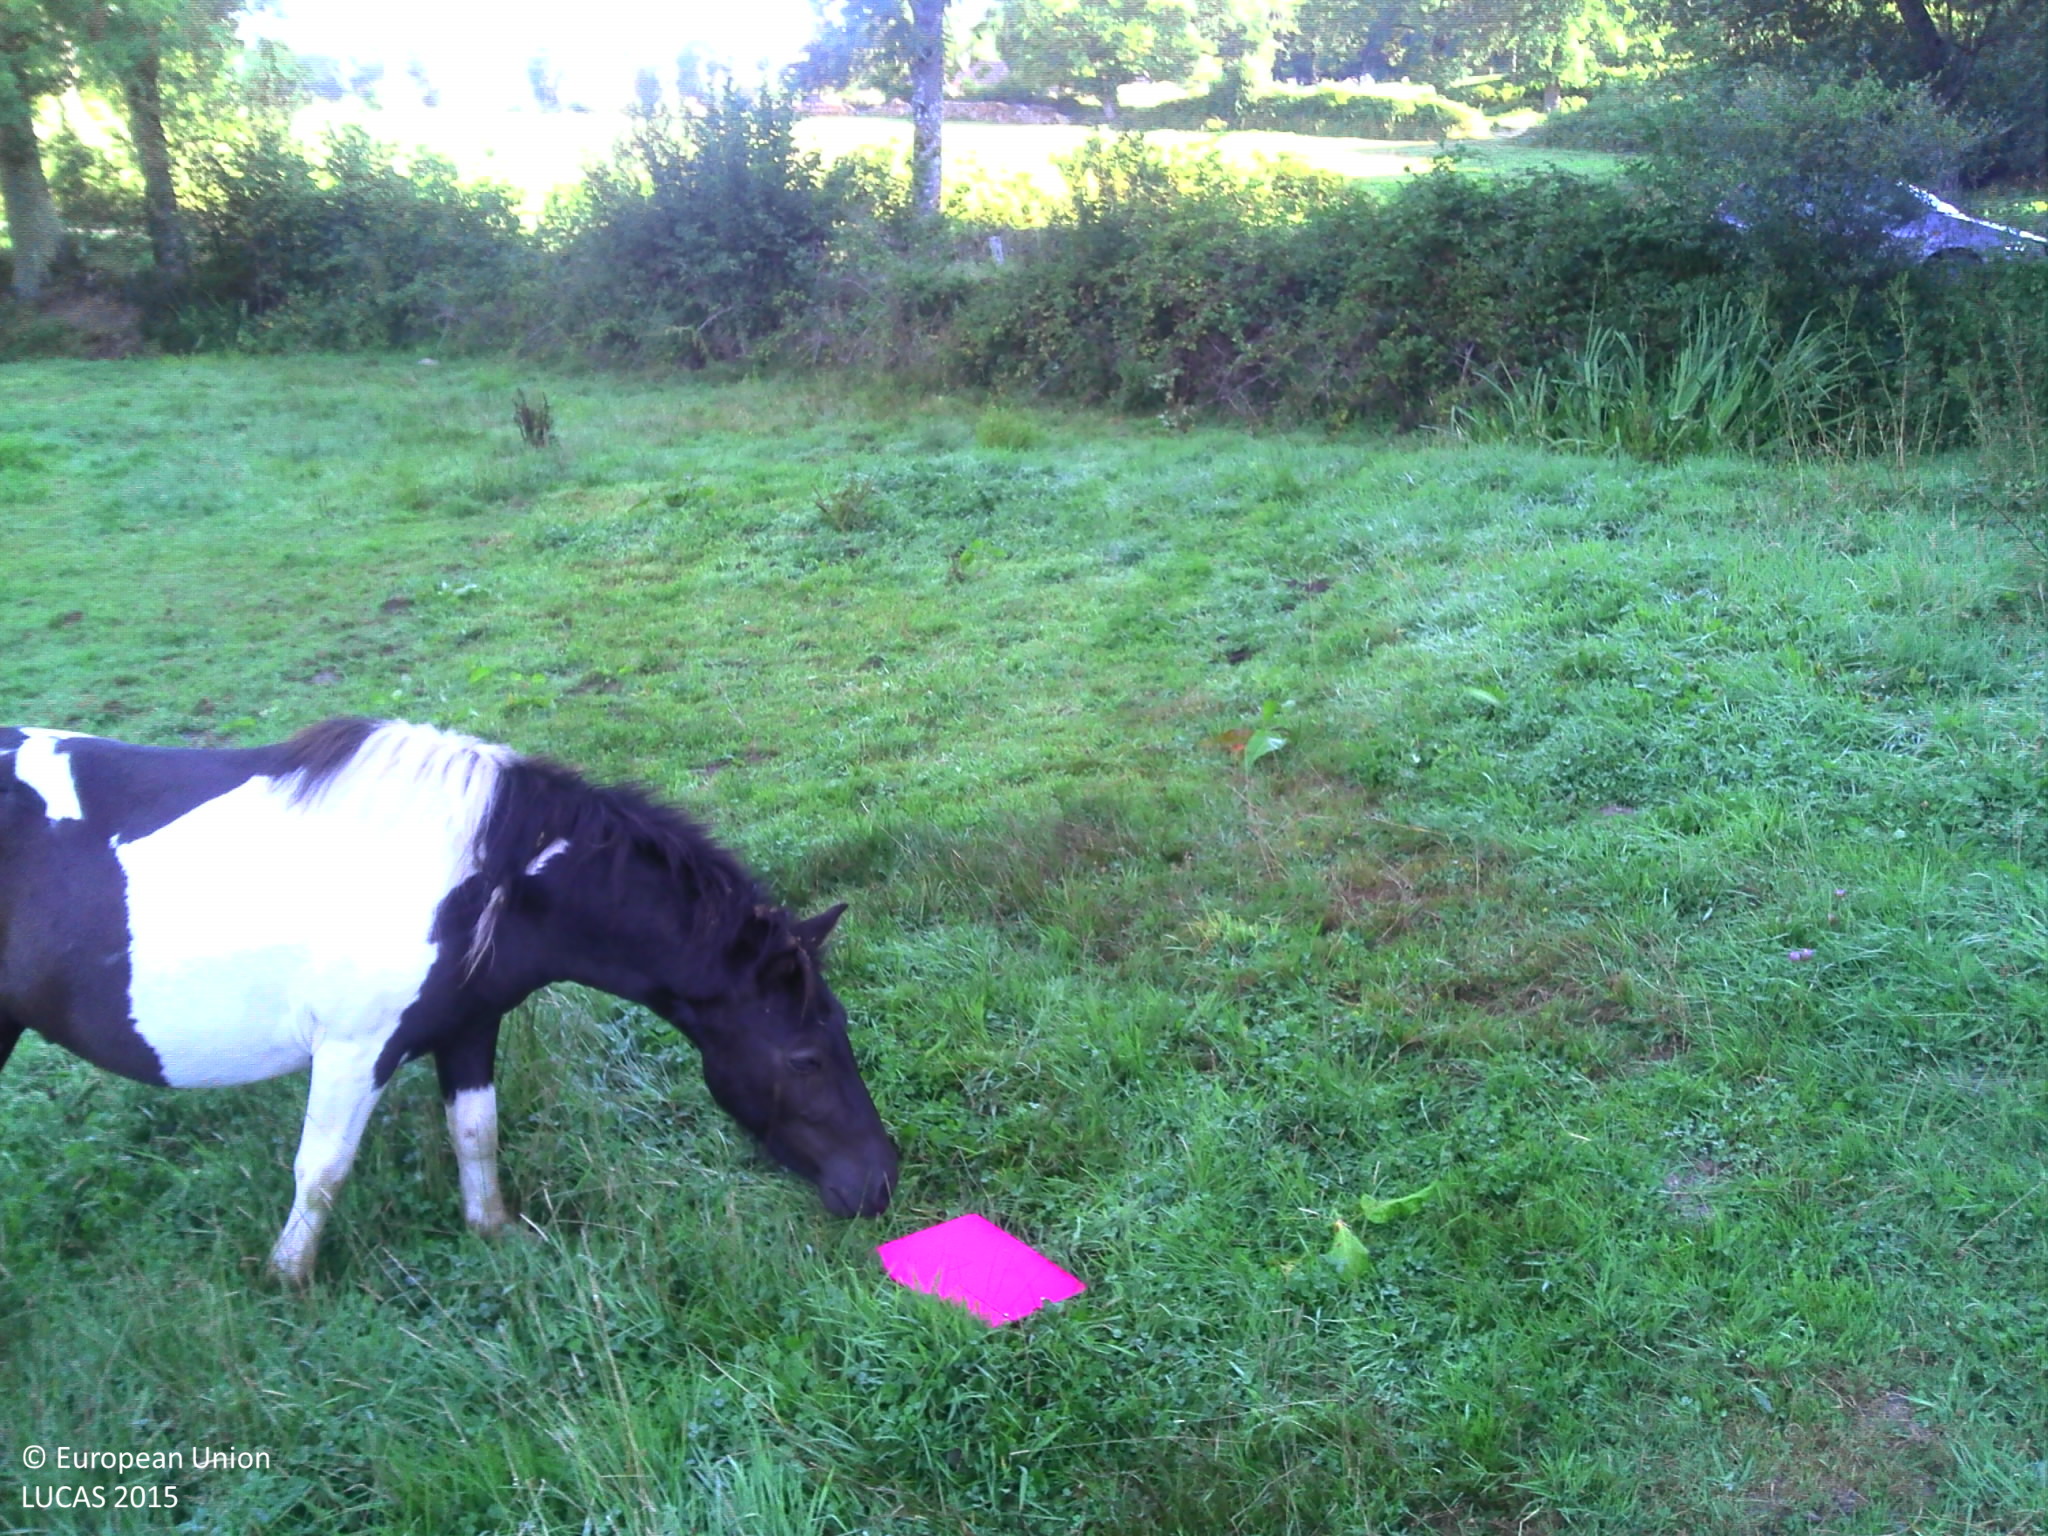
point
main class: Grassland
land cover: Grassland without tree/shrub cover
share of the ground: > 75 %
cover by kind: herbaceous plants 95 %, shrubs 5 %
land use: Agriculture (excluding fallow land and kitchen gardens)
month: August
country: FR
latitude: 45.8426
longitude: 2.3612
